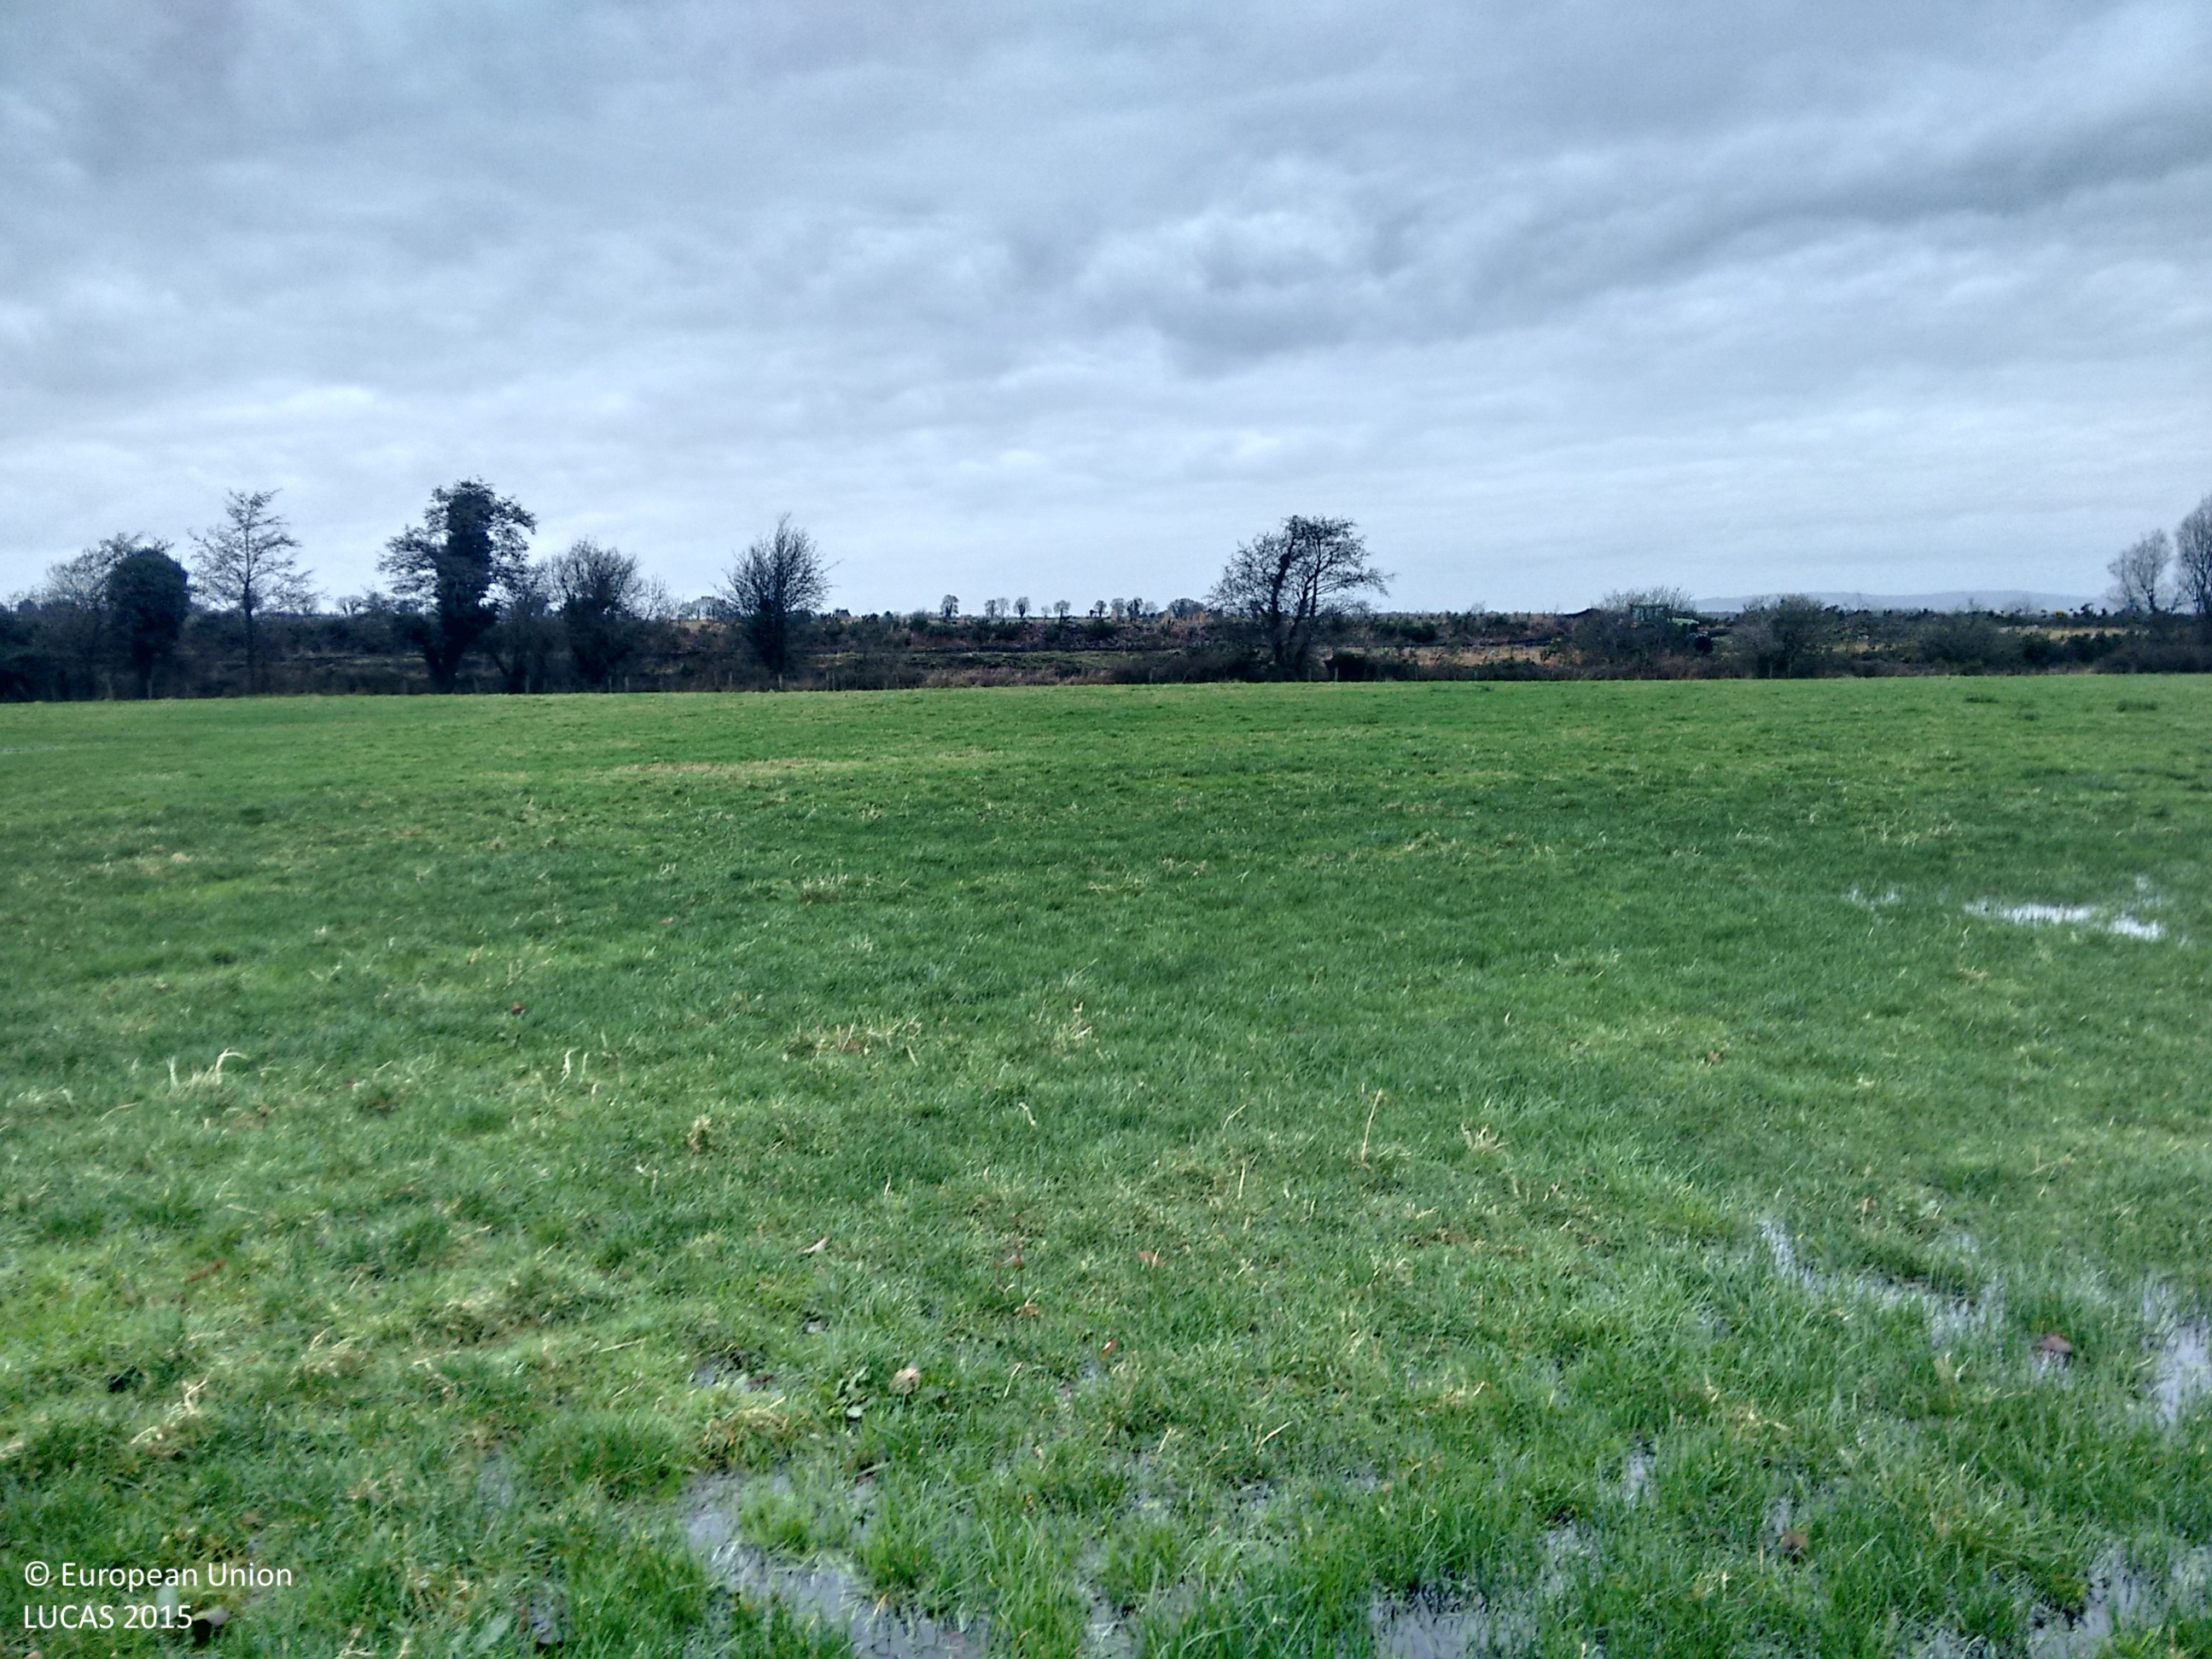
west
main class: Grassland
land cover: Grassland without tree/shrub cover
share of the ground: > 75 %
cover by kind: herbaceous plants 95 %
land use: Agriculture (excluding fallow land and kitchen gardens)
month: December
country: IE
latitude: 53.6584
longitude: -7.8906
